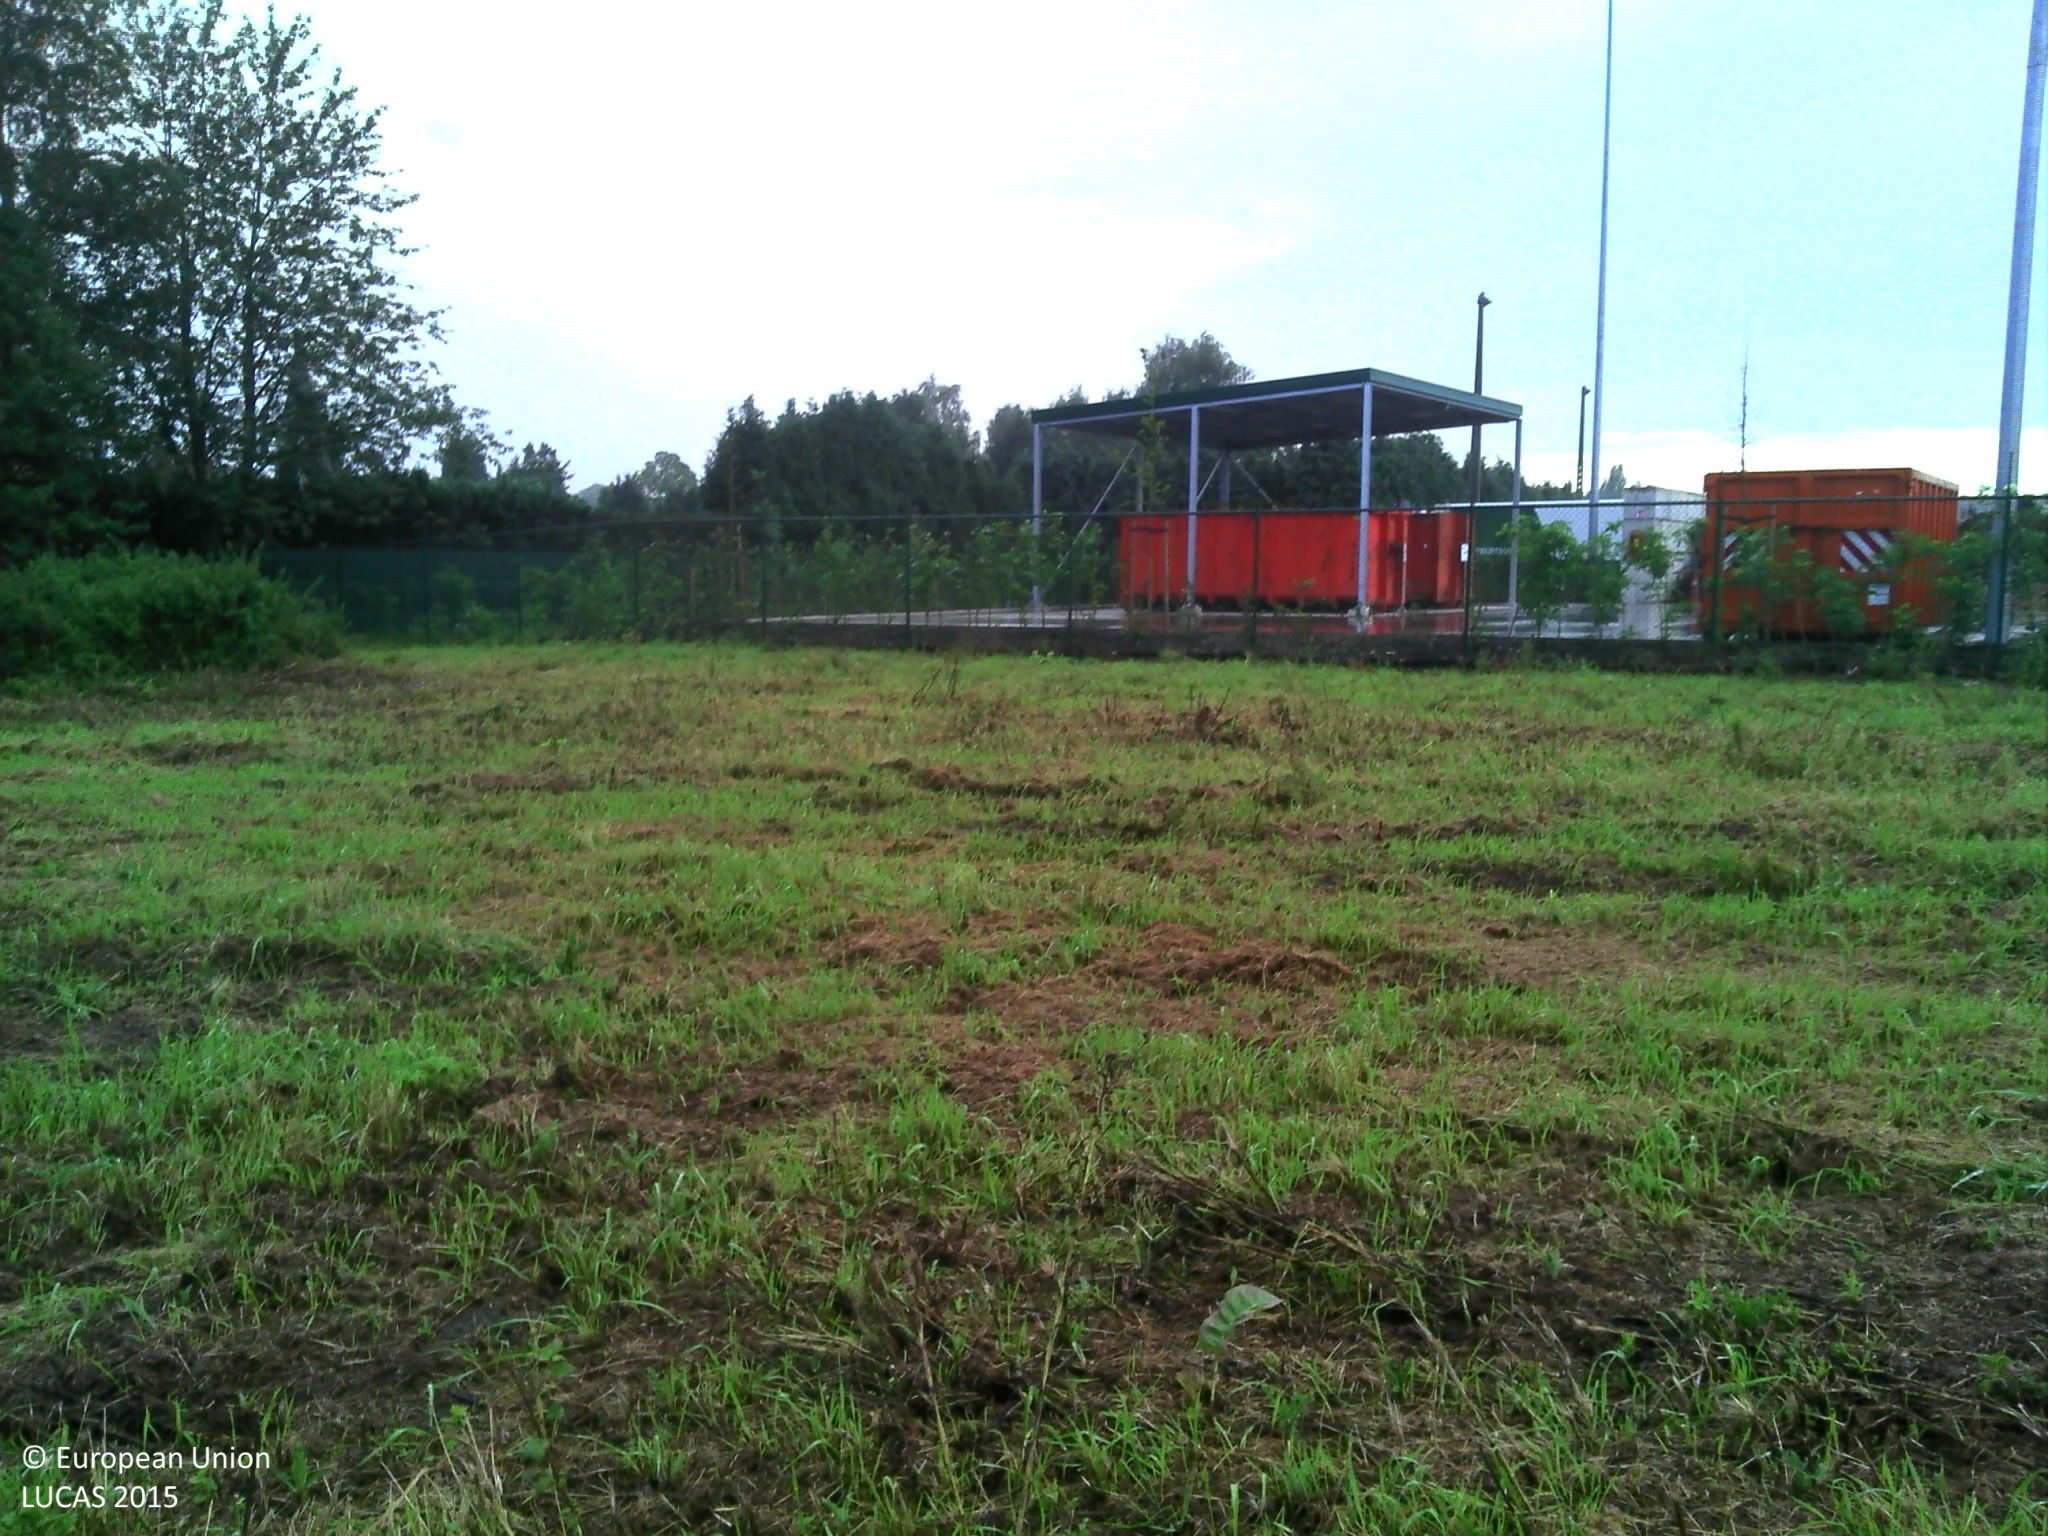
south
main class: Grassland
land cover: Grassland without tree/shrub cover
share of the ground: > 75 %
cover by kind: herbaceous plants 95 %, unconsolidated bare surface 5 %
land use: Agriculture (excluding fallow land and kitchen gardens)
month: September
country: BE
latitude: 51.3556
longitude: 4.6399
